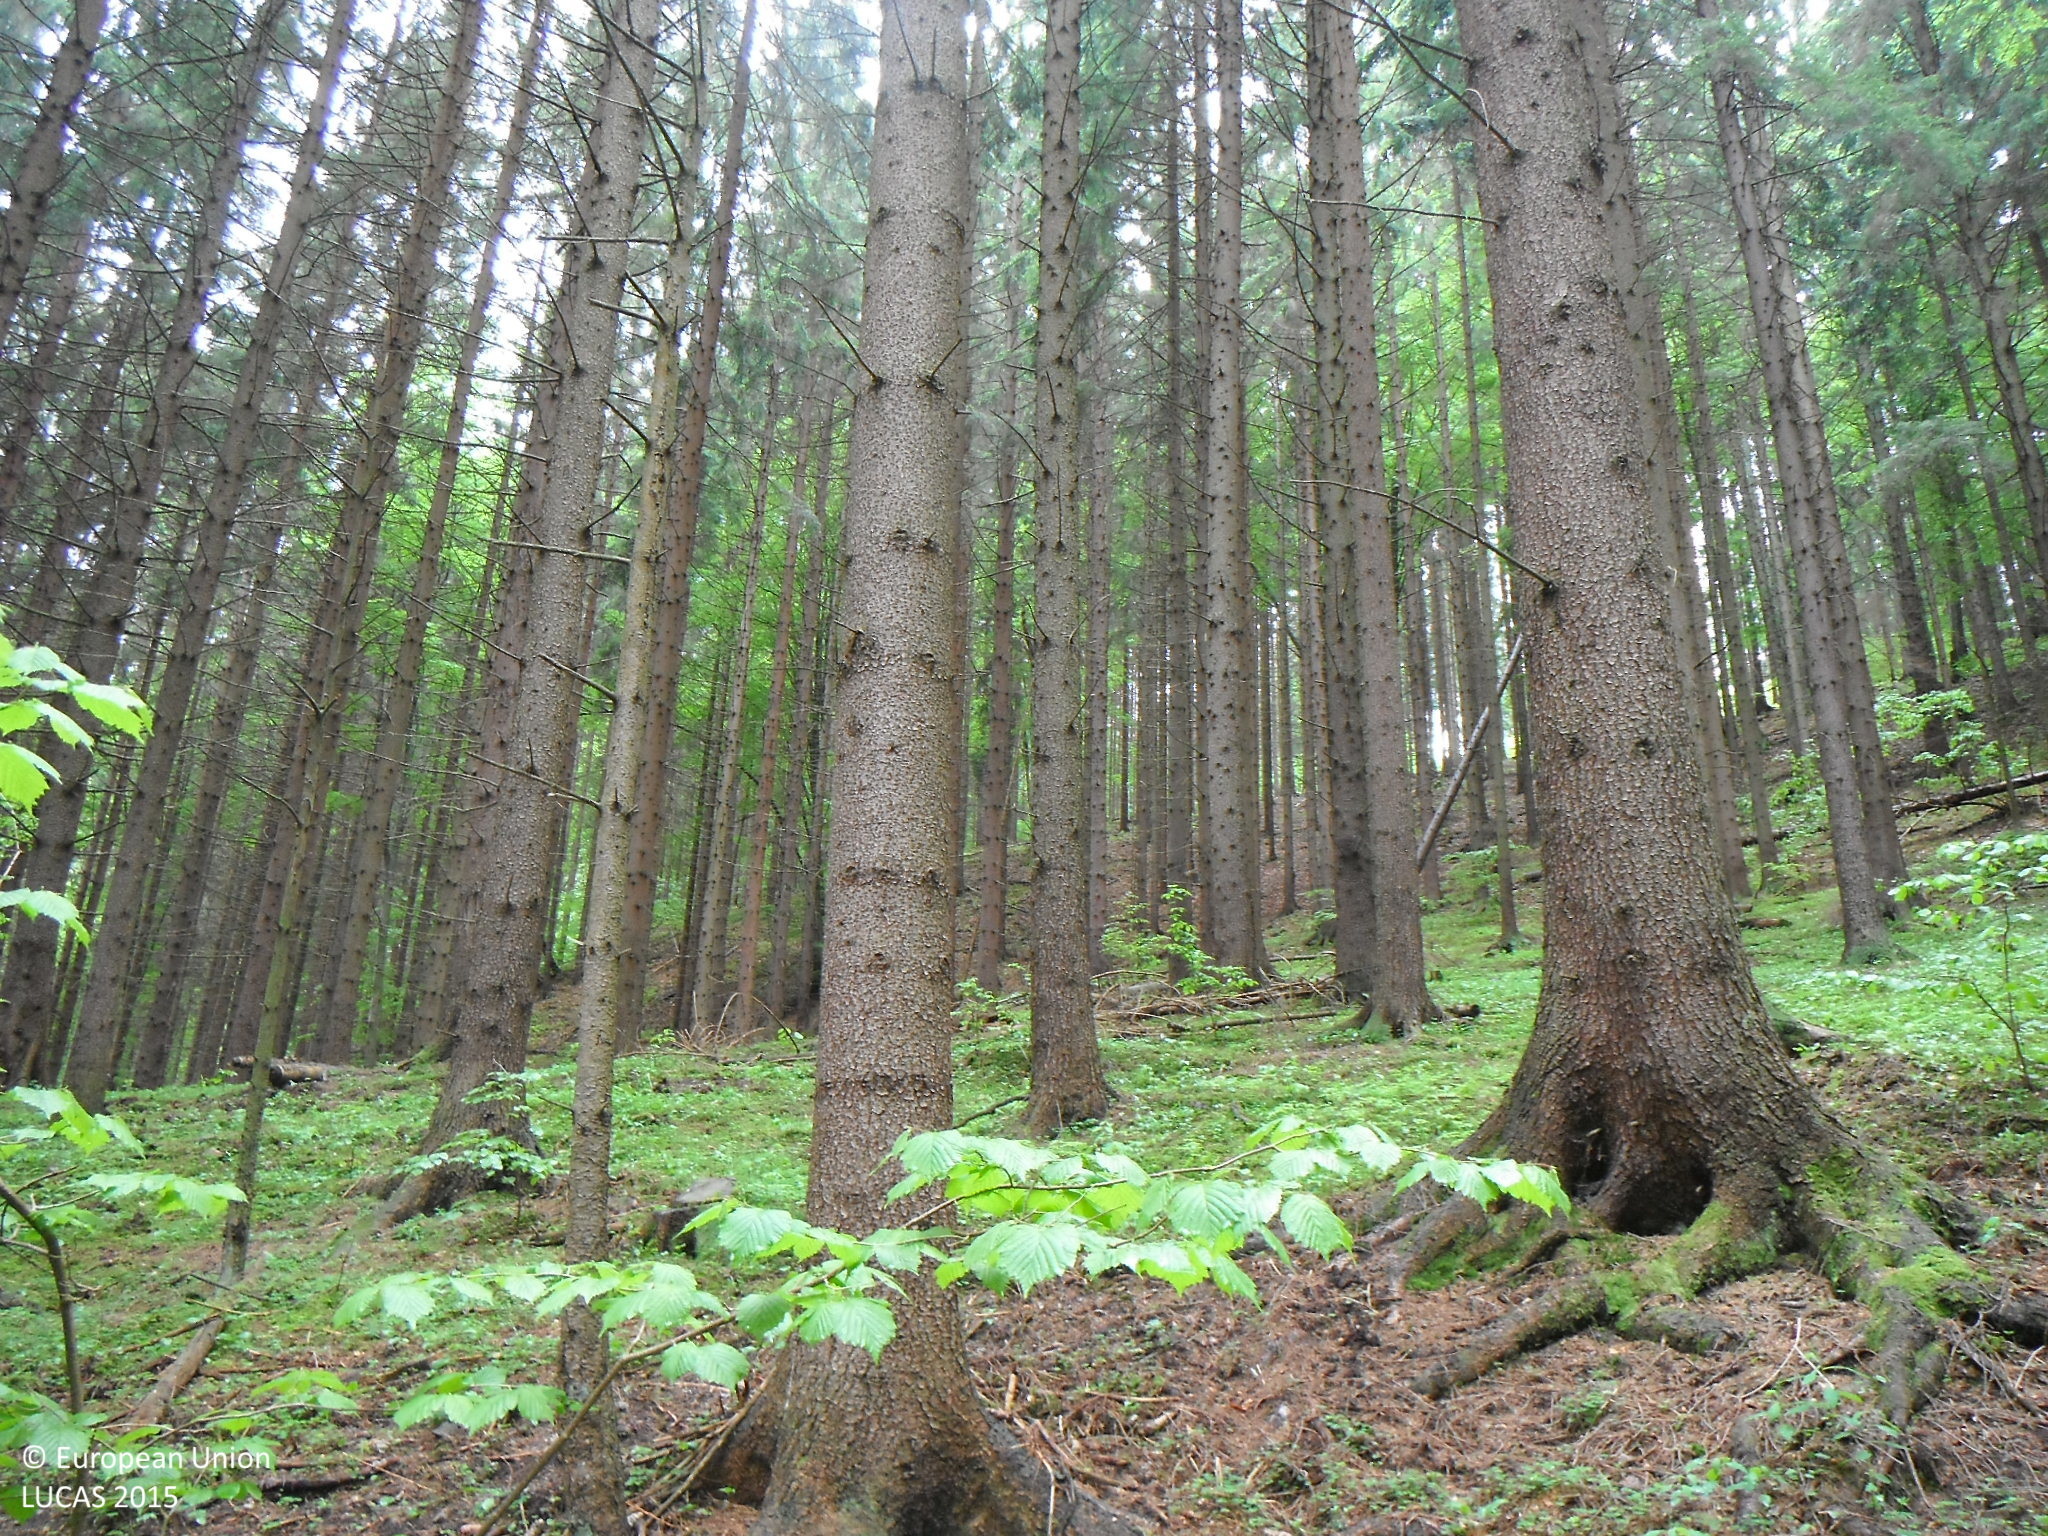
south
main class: Woodland
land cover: Spruce dominated coniferous woodland
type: alpine coniferous forest
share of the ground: > 75 %
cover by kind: coniferous forest trees 100 %
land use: Forestry
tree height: > 5 m
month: May
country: SK
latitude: 48.9929
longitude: 19.0283
